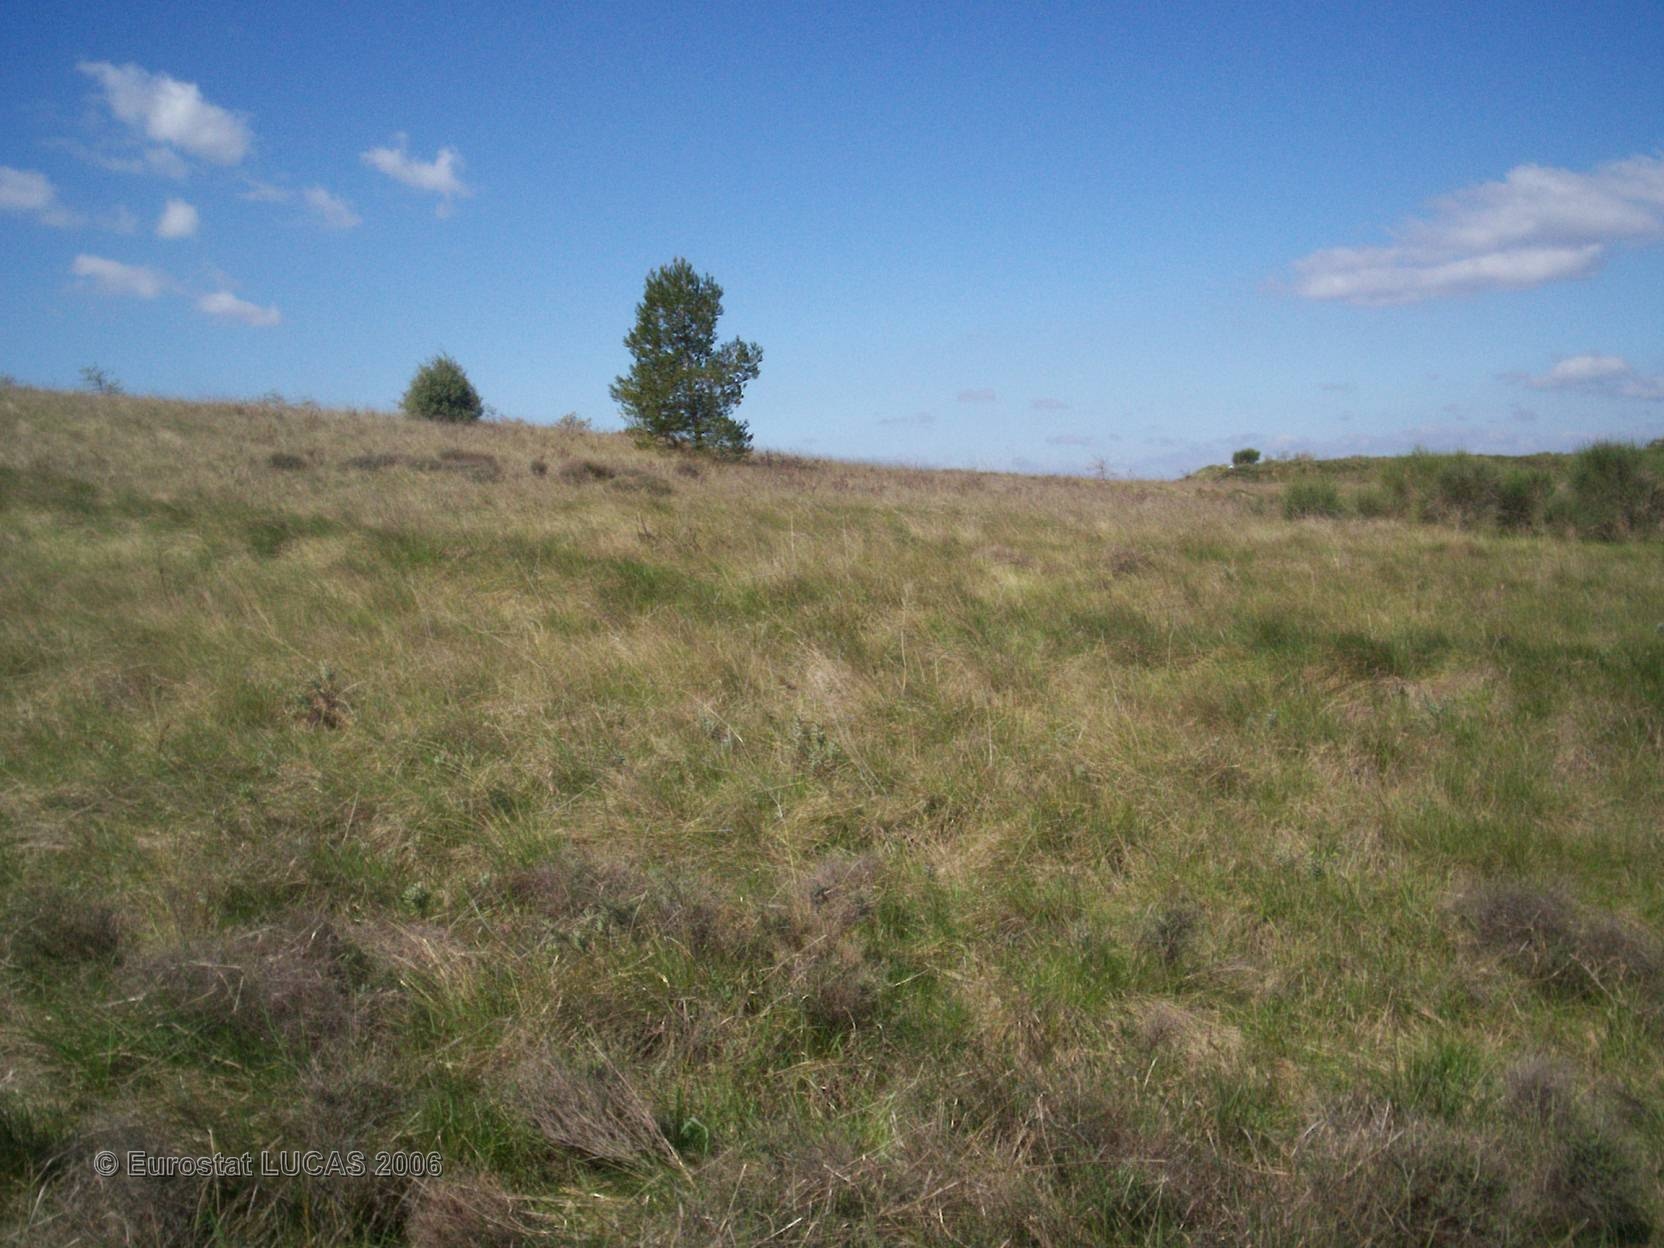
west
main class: Grassland
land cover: Grassland with sparse tree/shrub cover
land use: Unused
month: April
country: FR
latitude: 43.6057
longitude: 3.5293
